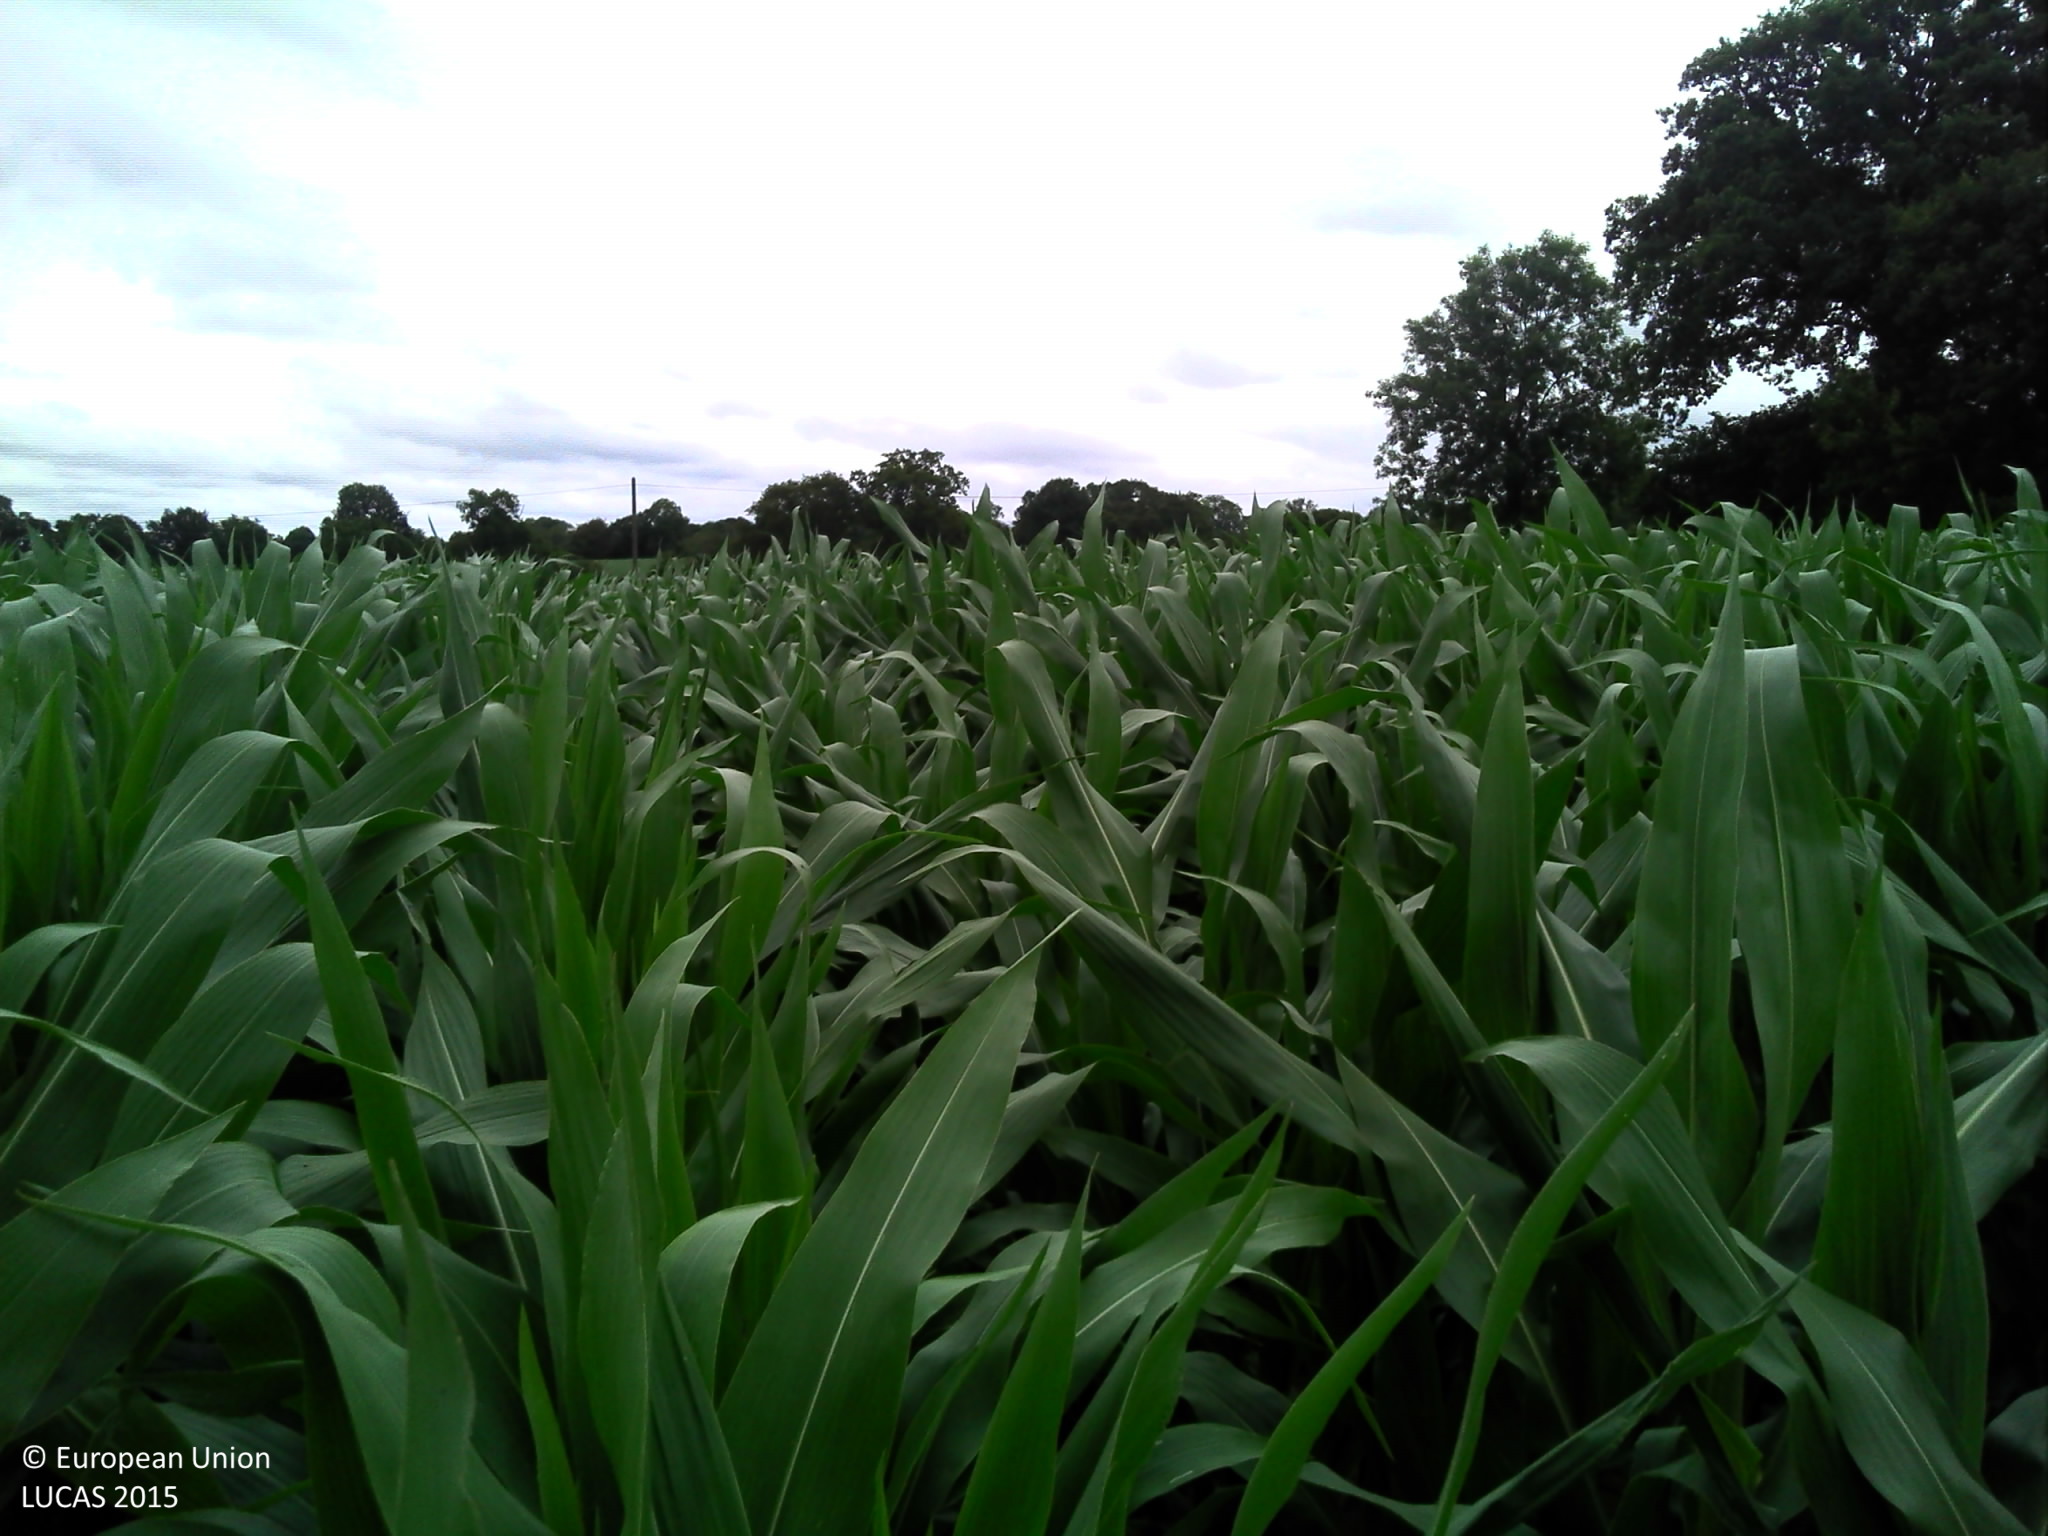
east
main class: Cropland
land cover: Maize
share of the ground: > 75 %
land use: Agriculture (excluding fallow land and kitchen gardens)
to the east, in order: Maize; Shruby margins; Ditches and canals; Grass margins; Paved roads, cycling and walking lanes; Grass margins; Ditches and canals; Electric lines; Shruby margins; Maize; Fences; Grassland without tree/shrub cover; Spontaneously vegetated surfaces; Rivers and streams; Single bushes/trees; Grassland without tree/shrub cover
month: July
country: FR
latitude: 48.9391
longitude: -1.3918
